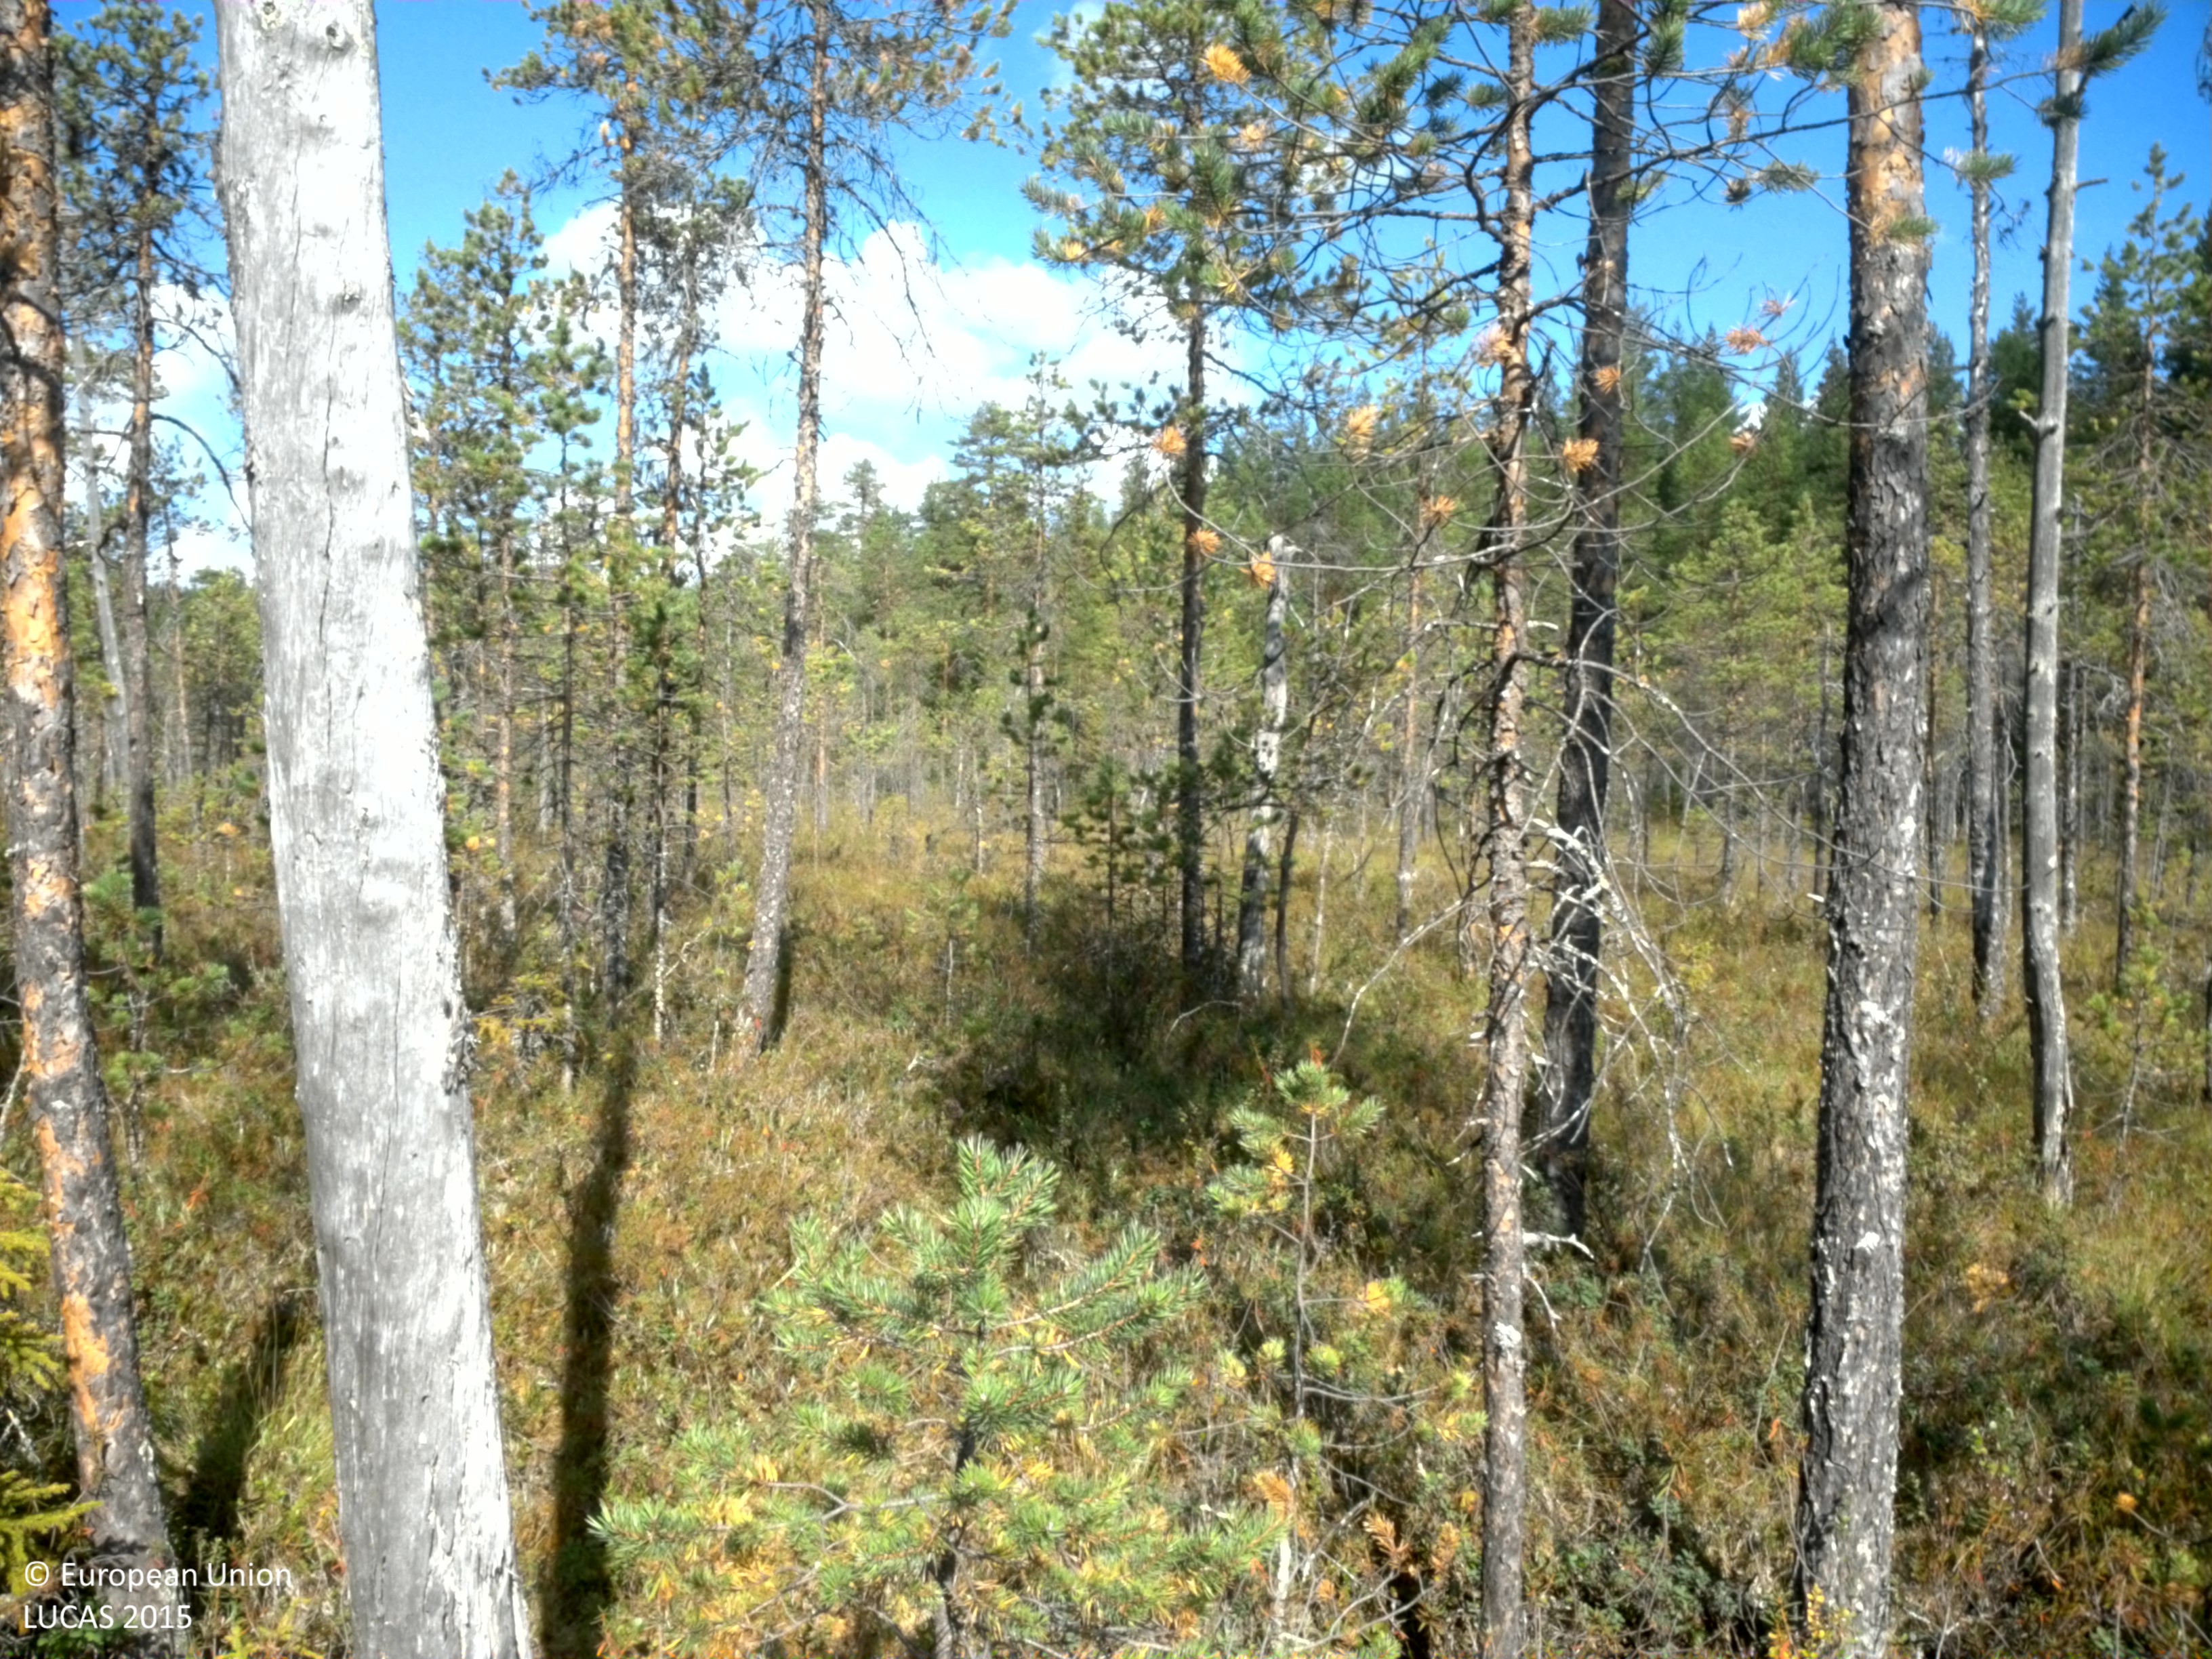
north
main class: Woodland
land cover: Pine dominated coniferous woodland
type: boreal forest
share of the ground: 25 - 50 %
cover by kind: coniferous forest trees 45 %, shrubs 40 %, lichens and mosses 10 %, herbaceous plants 5 %
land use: Forestry
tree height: > 5 m
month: August
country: SE
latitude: 64.5877
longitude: 18.8448
